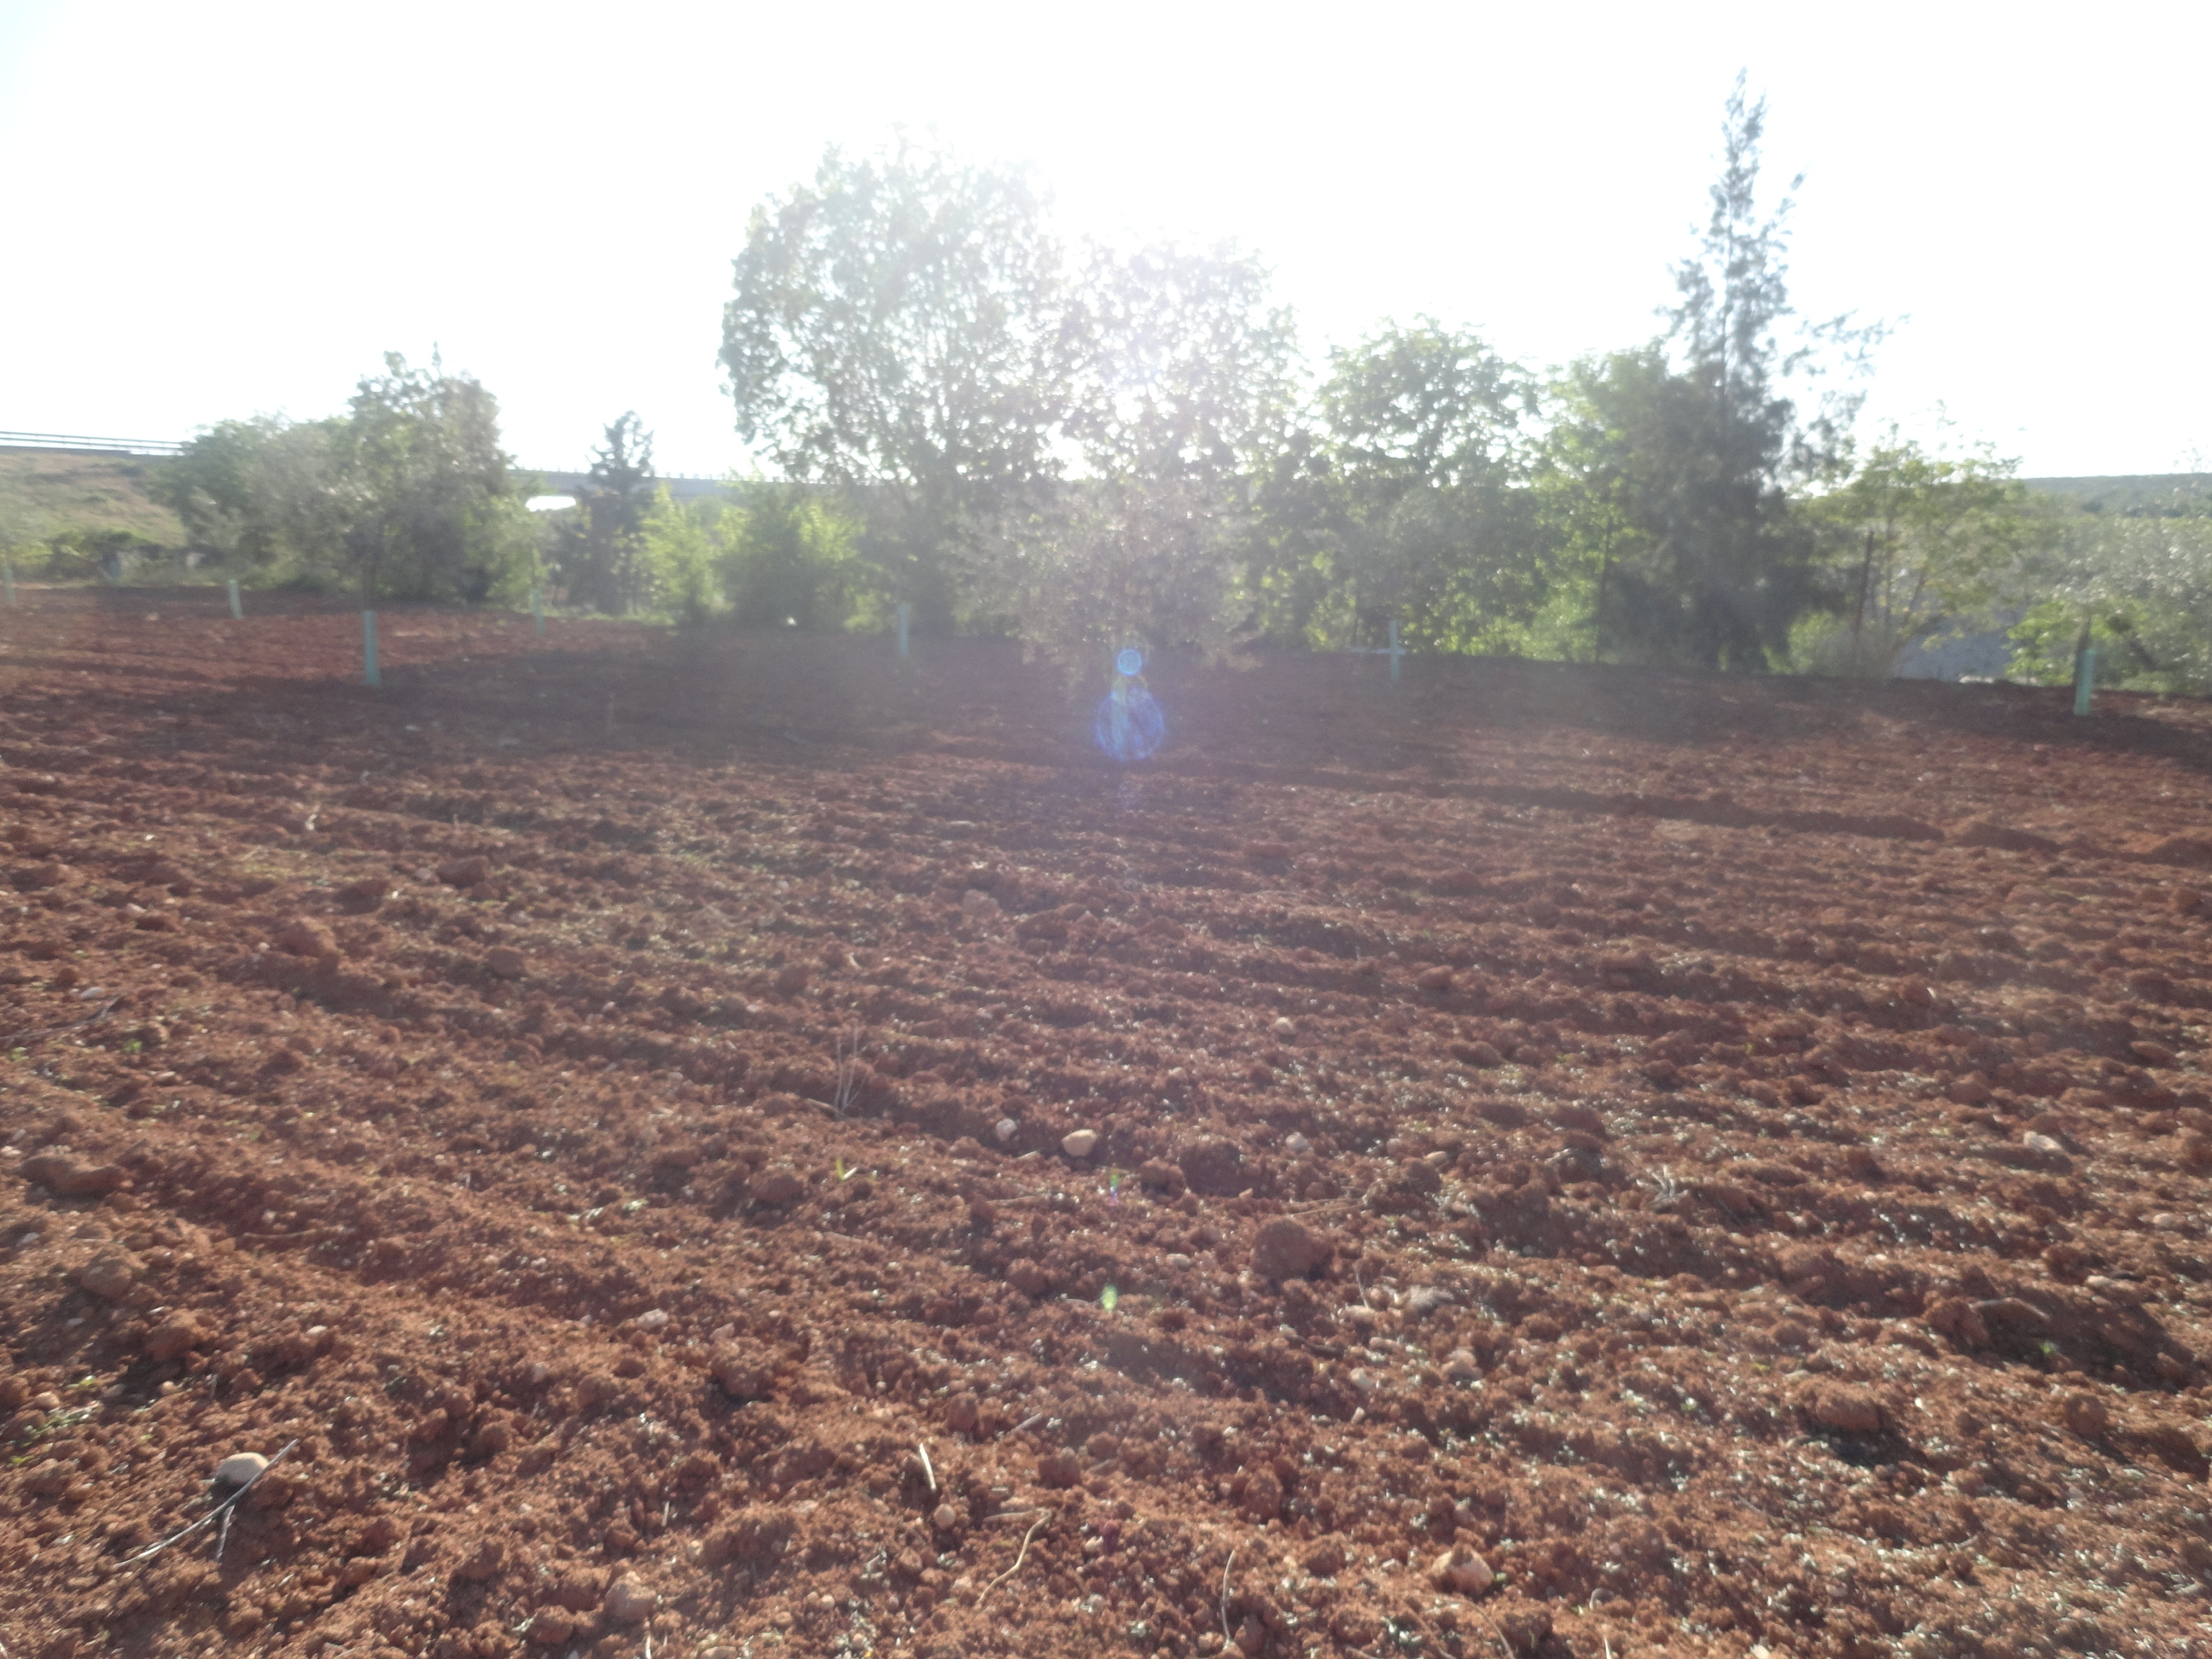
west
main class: Cropland
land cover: Olive groves
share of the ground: 10 - 25 %
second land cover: Other bare soil
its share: > 75 %
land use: Agriculture (excluding fallow land and kitchen gardens)
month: April
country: ES
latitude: 37.4635
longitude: -4.5781
